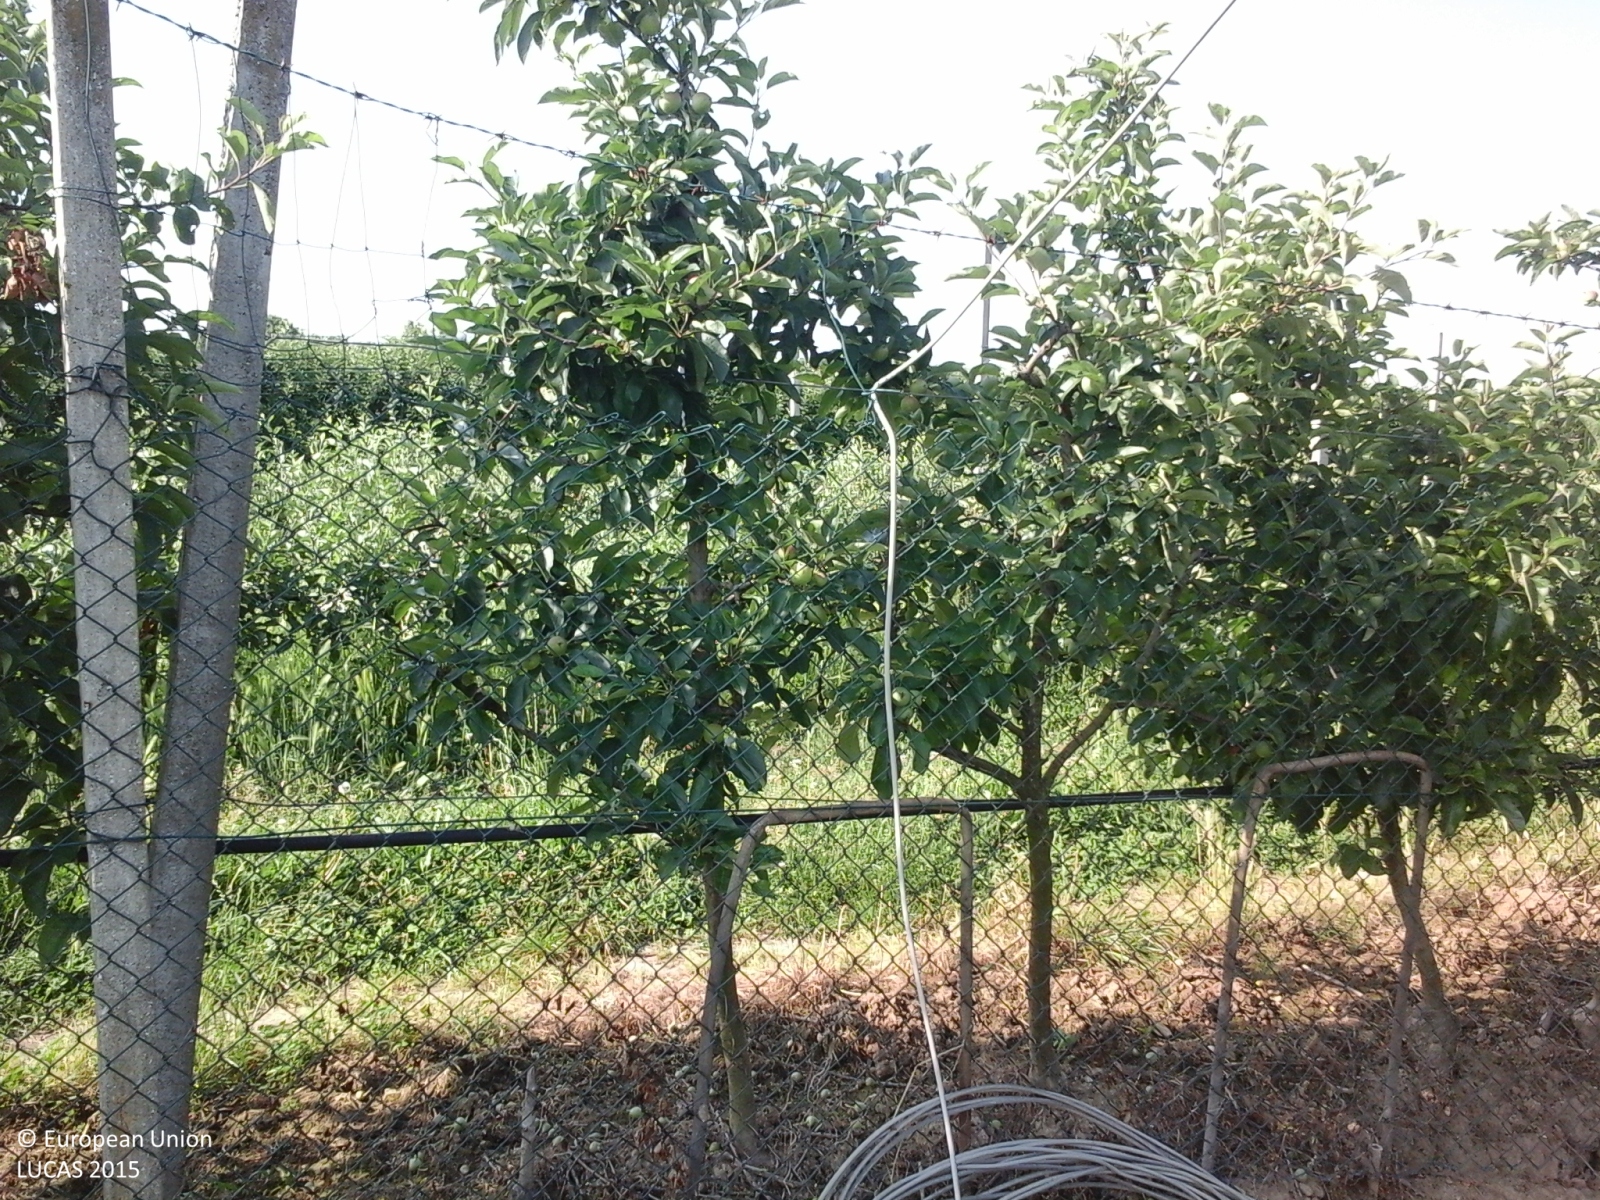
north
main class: Cropland
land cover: Apple fruit
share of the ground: 25 - 50 %
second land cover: Grassland without tree/shrub cover
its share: > 75 %
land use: Agriculture (excluding fallow land and kitchen gardens)
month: May
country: IT
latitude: 45.2475
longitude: 10.9793
